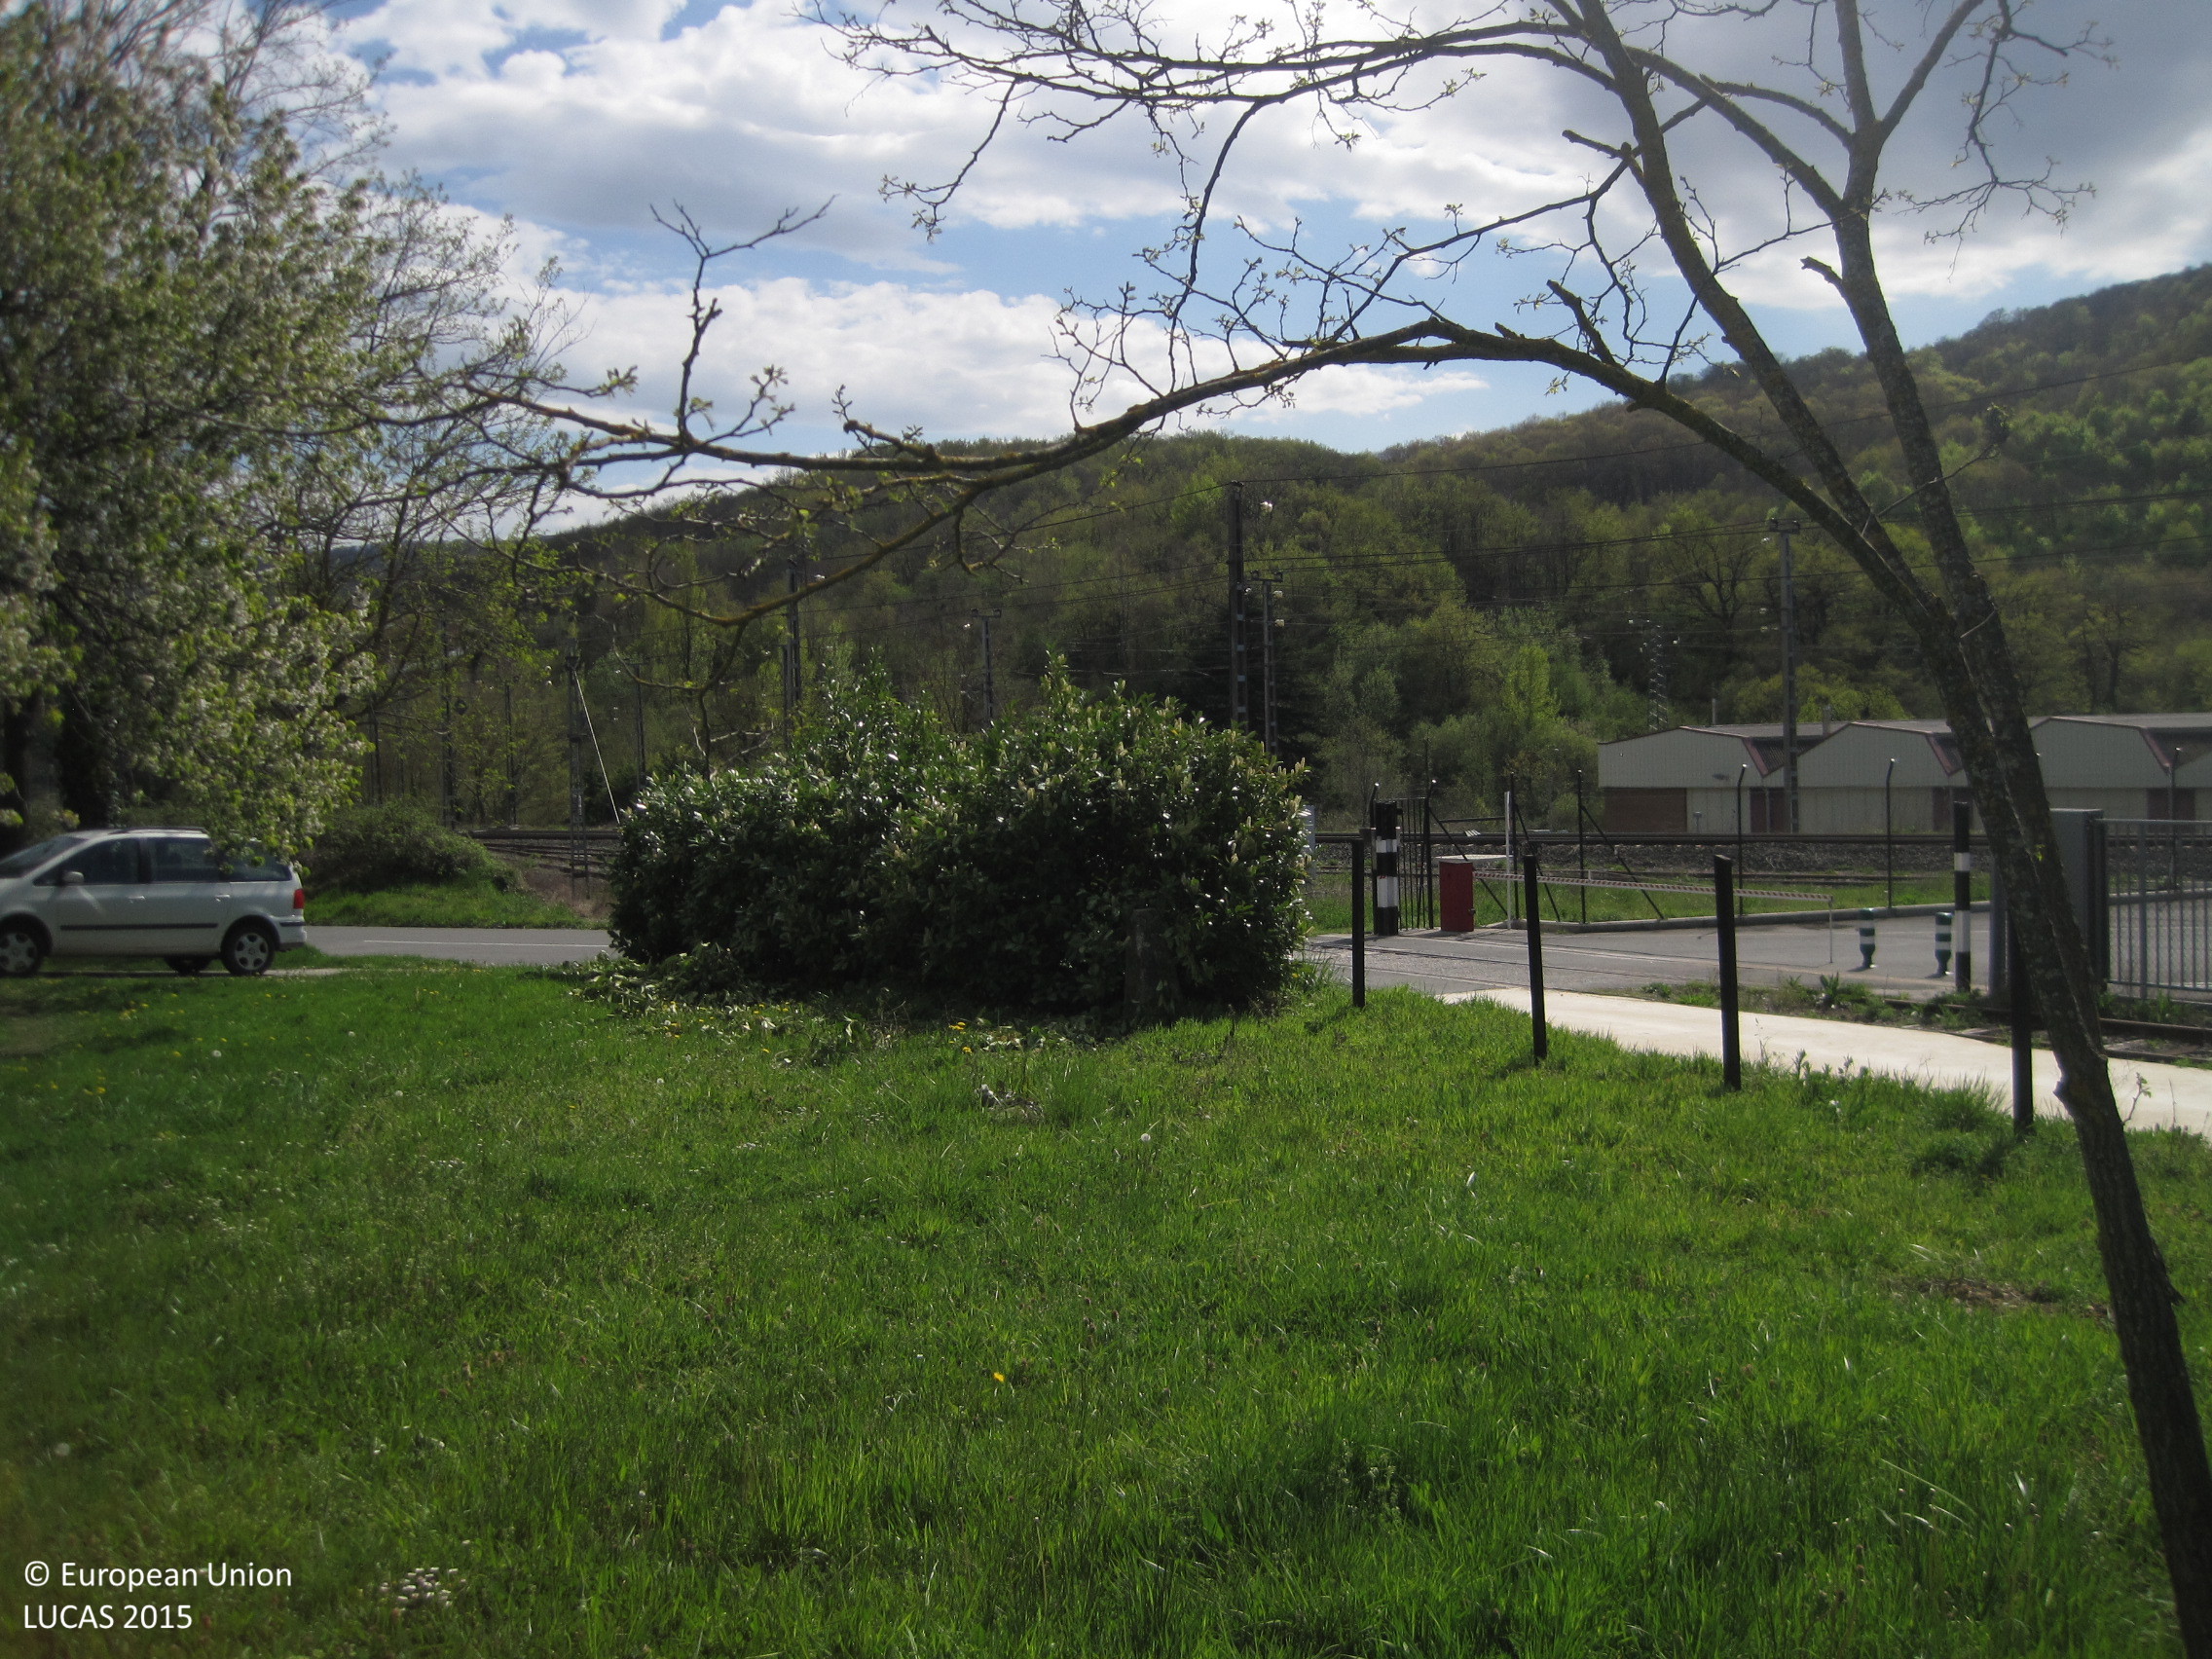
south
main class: Grassland
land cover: Grassland without tree/shrub cover
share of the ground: > 75 %
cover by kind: herbaceous plants 100 %
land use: Agriculture (excluding fallow land and kitchen gardens)
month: April
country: ES
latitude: 42.9006
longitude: -2.1826
